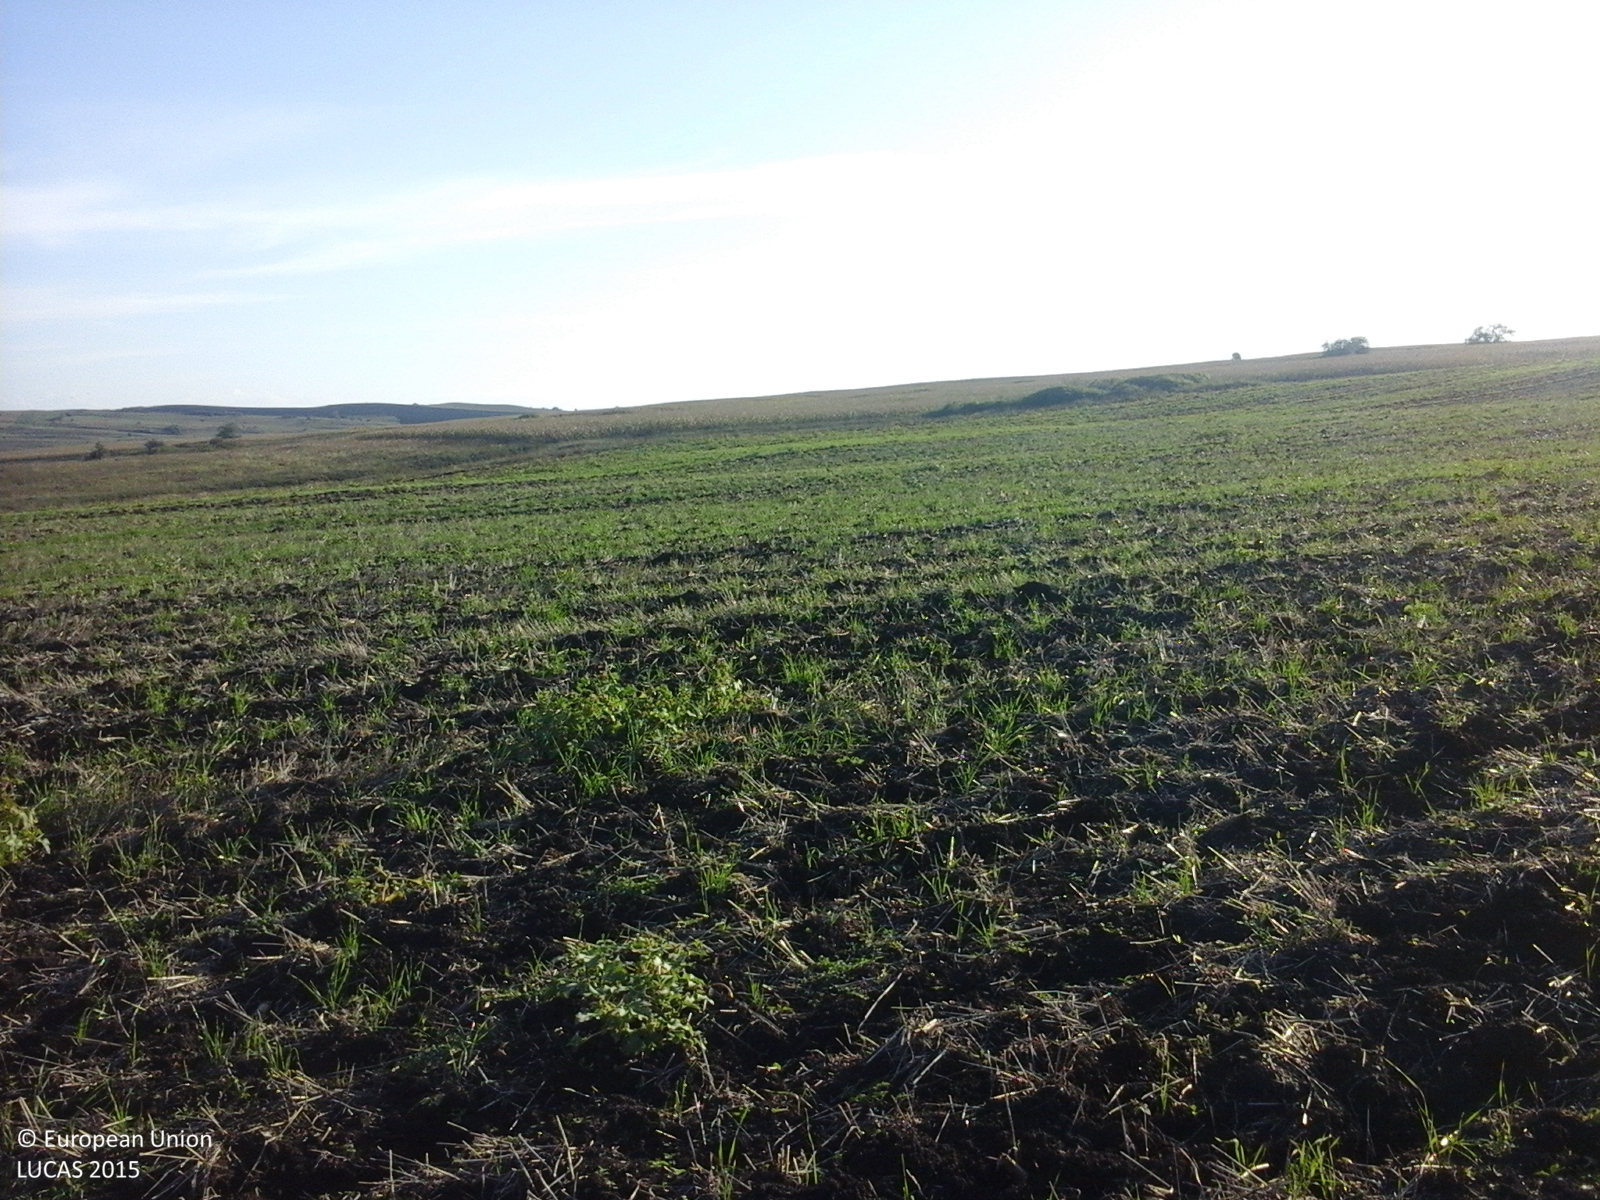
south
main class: Cropland
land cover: Common wheat
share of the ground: 25 - 50 %
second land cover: Spontaneously vegetated surfaces
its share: 25 - 50 %
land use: Agriculture (excluding fallow land and kitchen gardens)
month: October
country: RO
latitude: 46.2219
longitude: 23.7741
